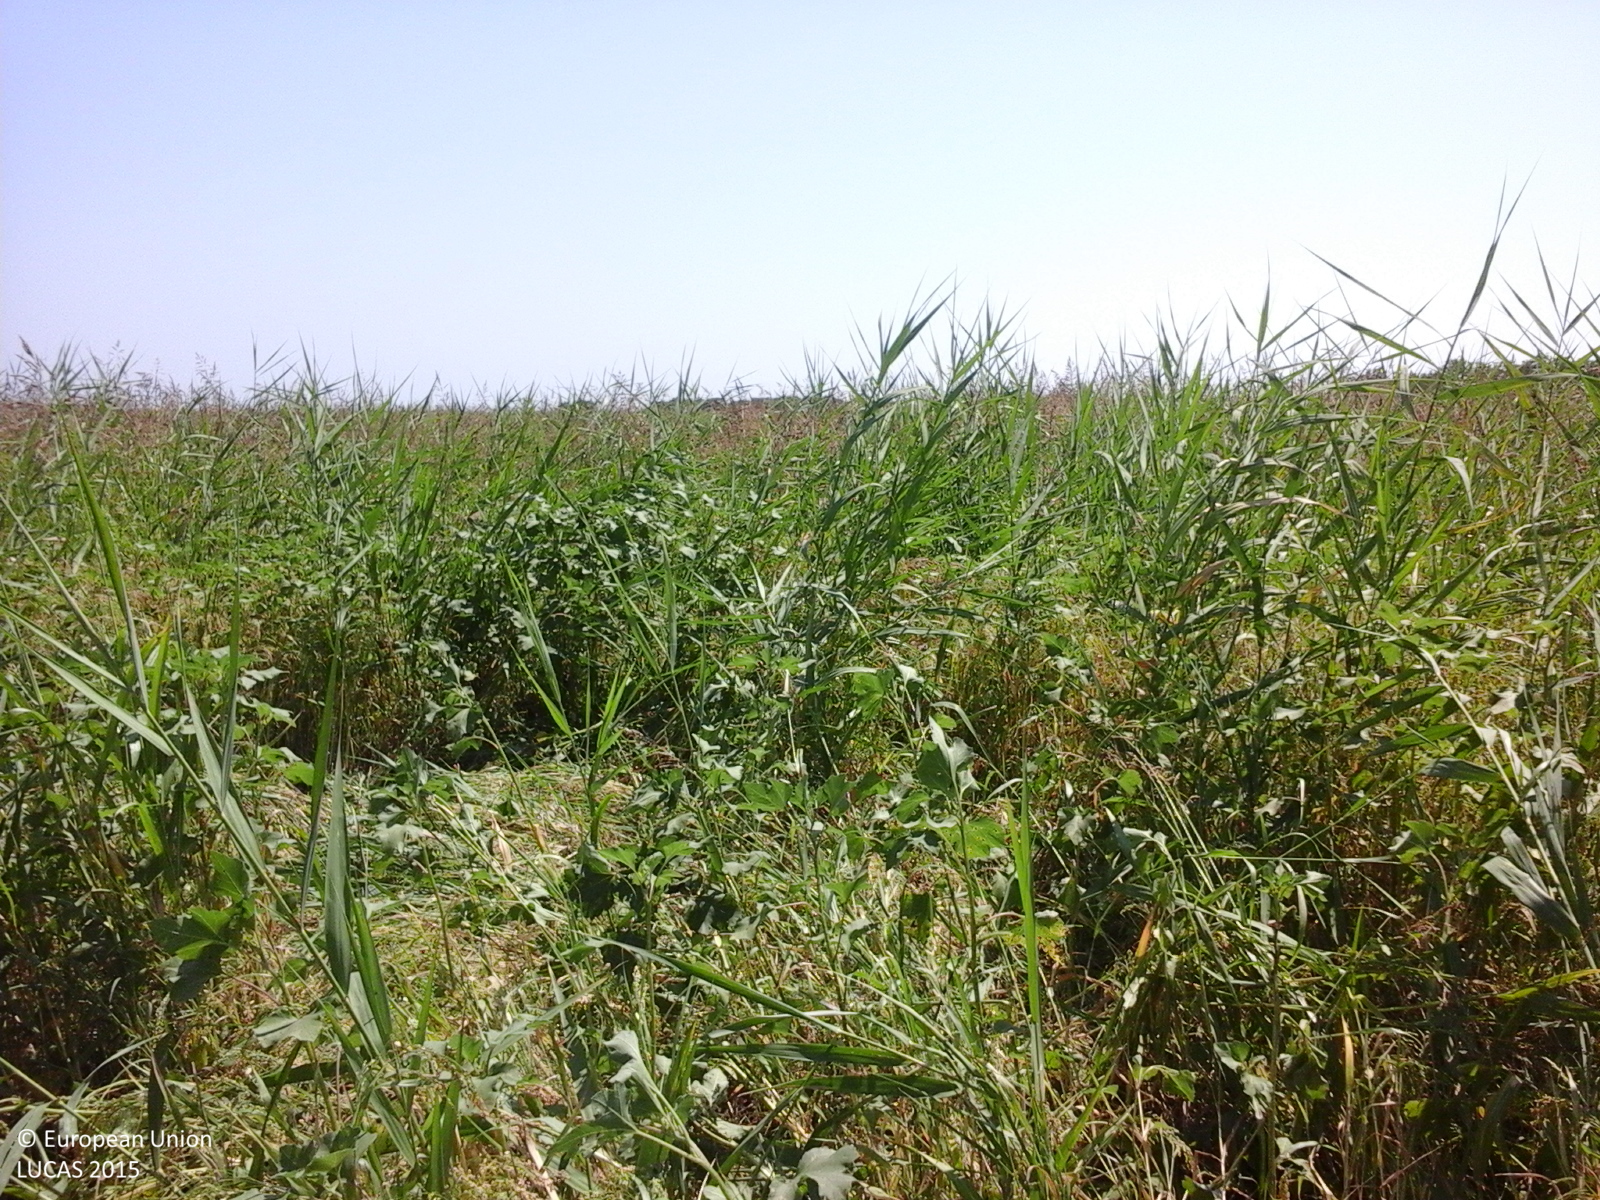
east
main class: Grassland
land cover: Spontaneously vegetated surfaces
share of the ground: > 75 %
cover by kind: herbaceous plants 100 %
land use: Fallow land
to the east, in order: Spontaneously vegetated surfaces; Grassland without tree/shrub cover; Tracks; Grassland without tree/shrub cover; Maize; Common wheat; Oats
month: July
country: RO
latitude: 45.0383
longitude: 27.1883
